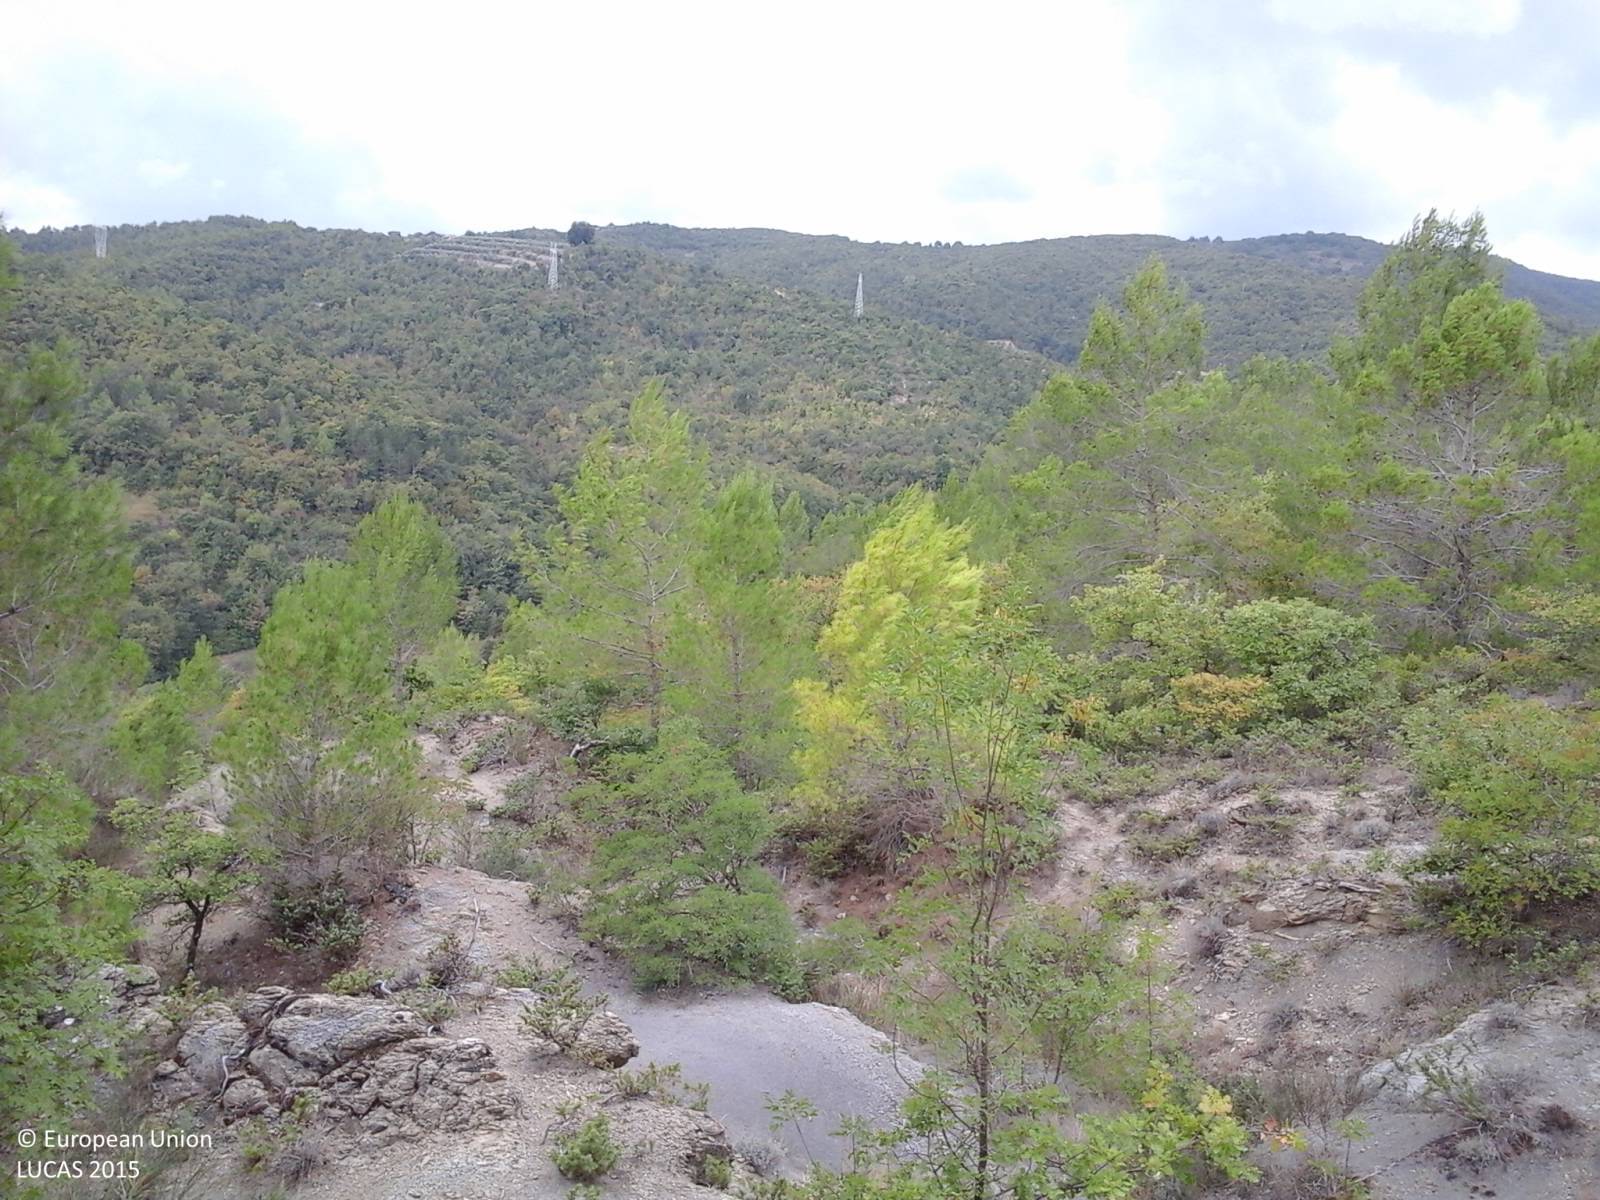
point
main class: Woodland
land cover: Broadleaved woodland
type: thermophilous deciduous forest
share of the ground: > 75 %
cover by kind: broadleaved forest trees 100 %
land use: Forestry
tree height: > 5 m
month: September
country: IT
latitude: 42.9179
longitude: 12.2594
